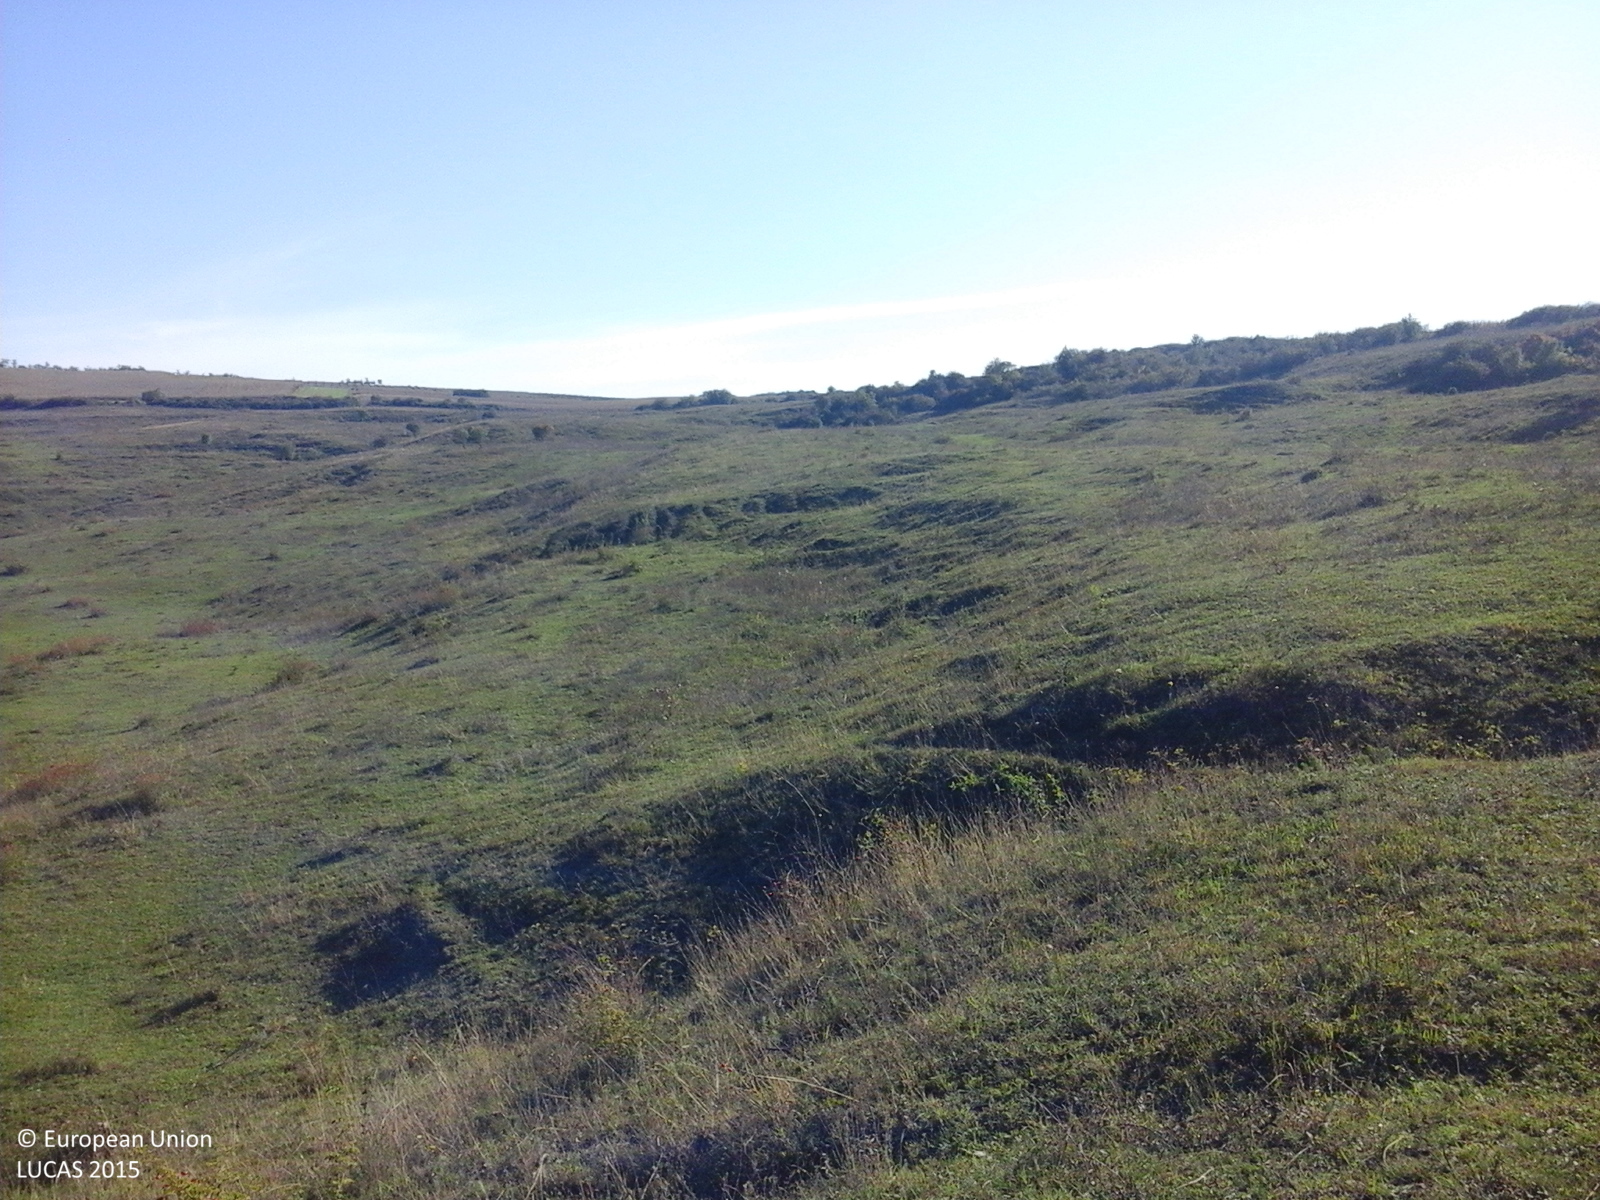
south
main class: Grassland
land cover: Grassland without tree/shrub cover
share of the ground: > 75 %
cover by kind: herbaceous plants 100 %
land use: Agriculture (excluding fallow land and kitchen gardens)
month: October
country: RO
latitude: 46.2859
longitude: 23.8437
